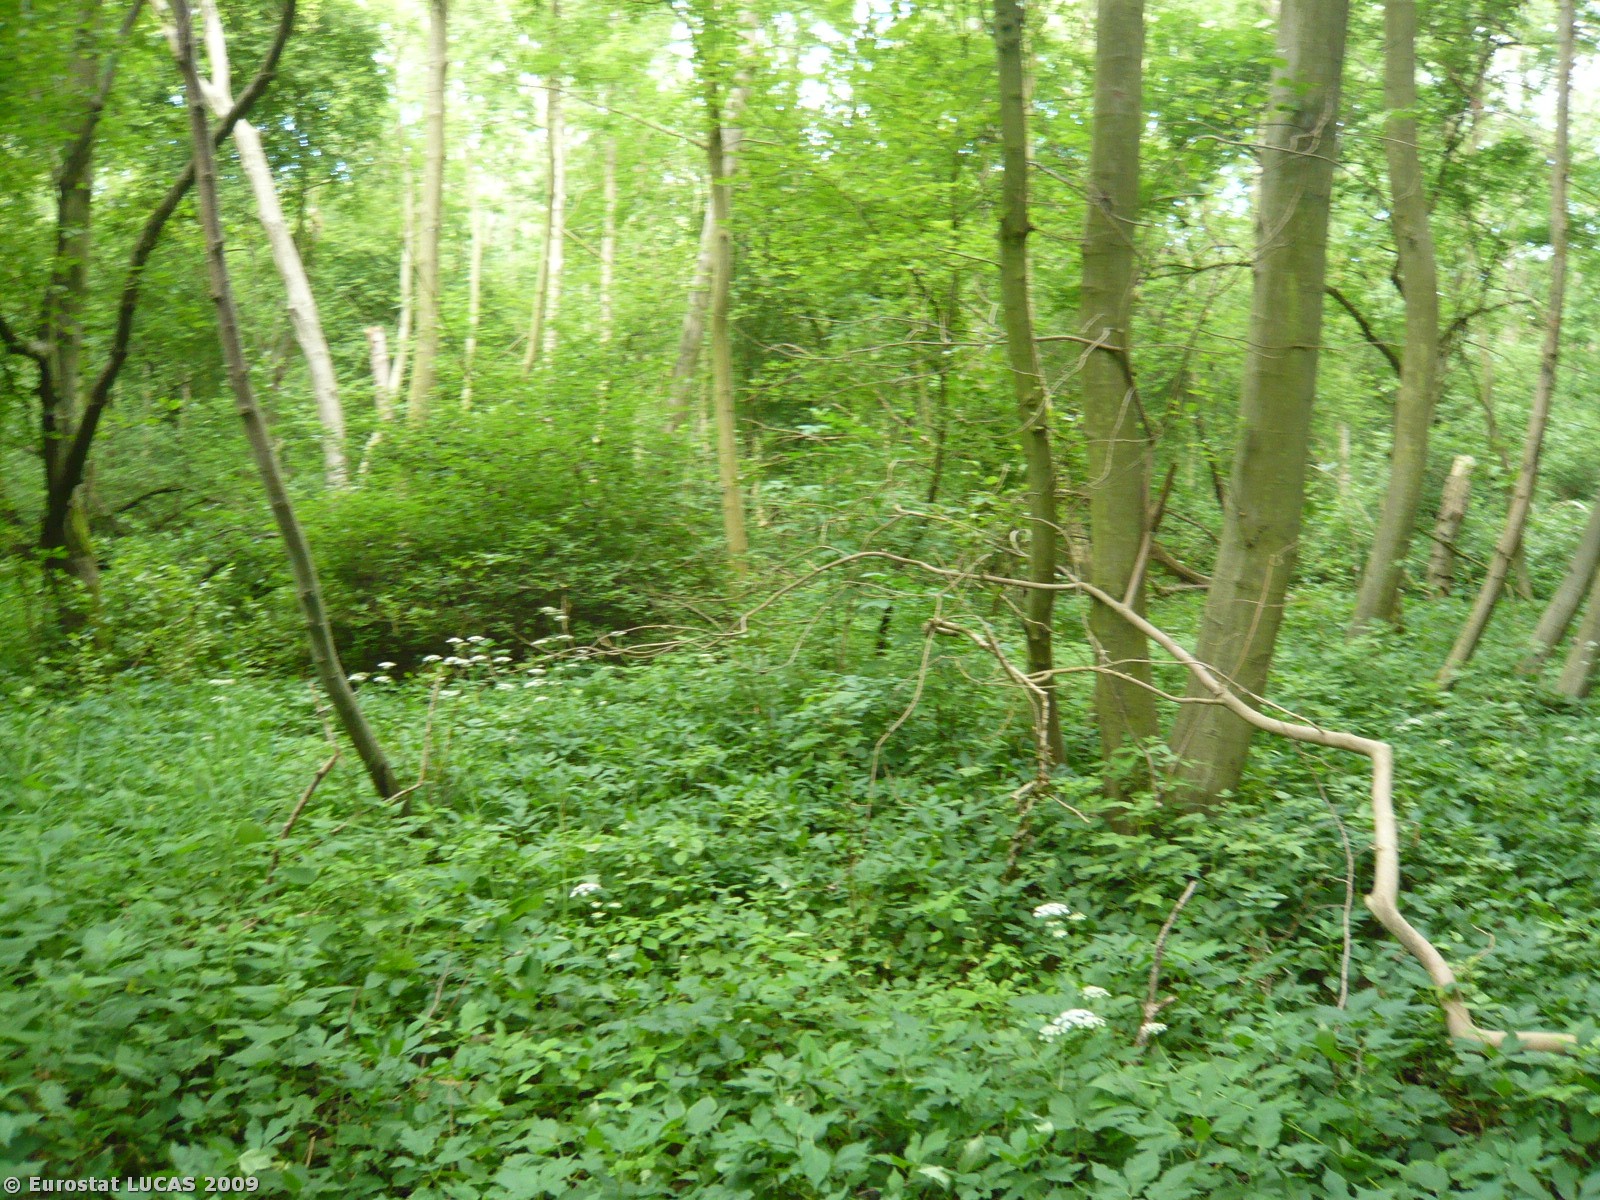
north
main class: Woodland
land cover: Broadleaved woodland
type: mesophytic deciduous forest
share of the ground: > 75 %
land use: Forestry
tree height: > 5 m
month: June
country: DK
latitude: 54.7747
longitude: 11.6623
